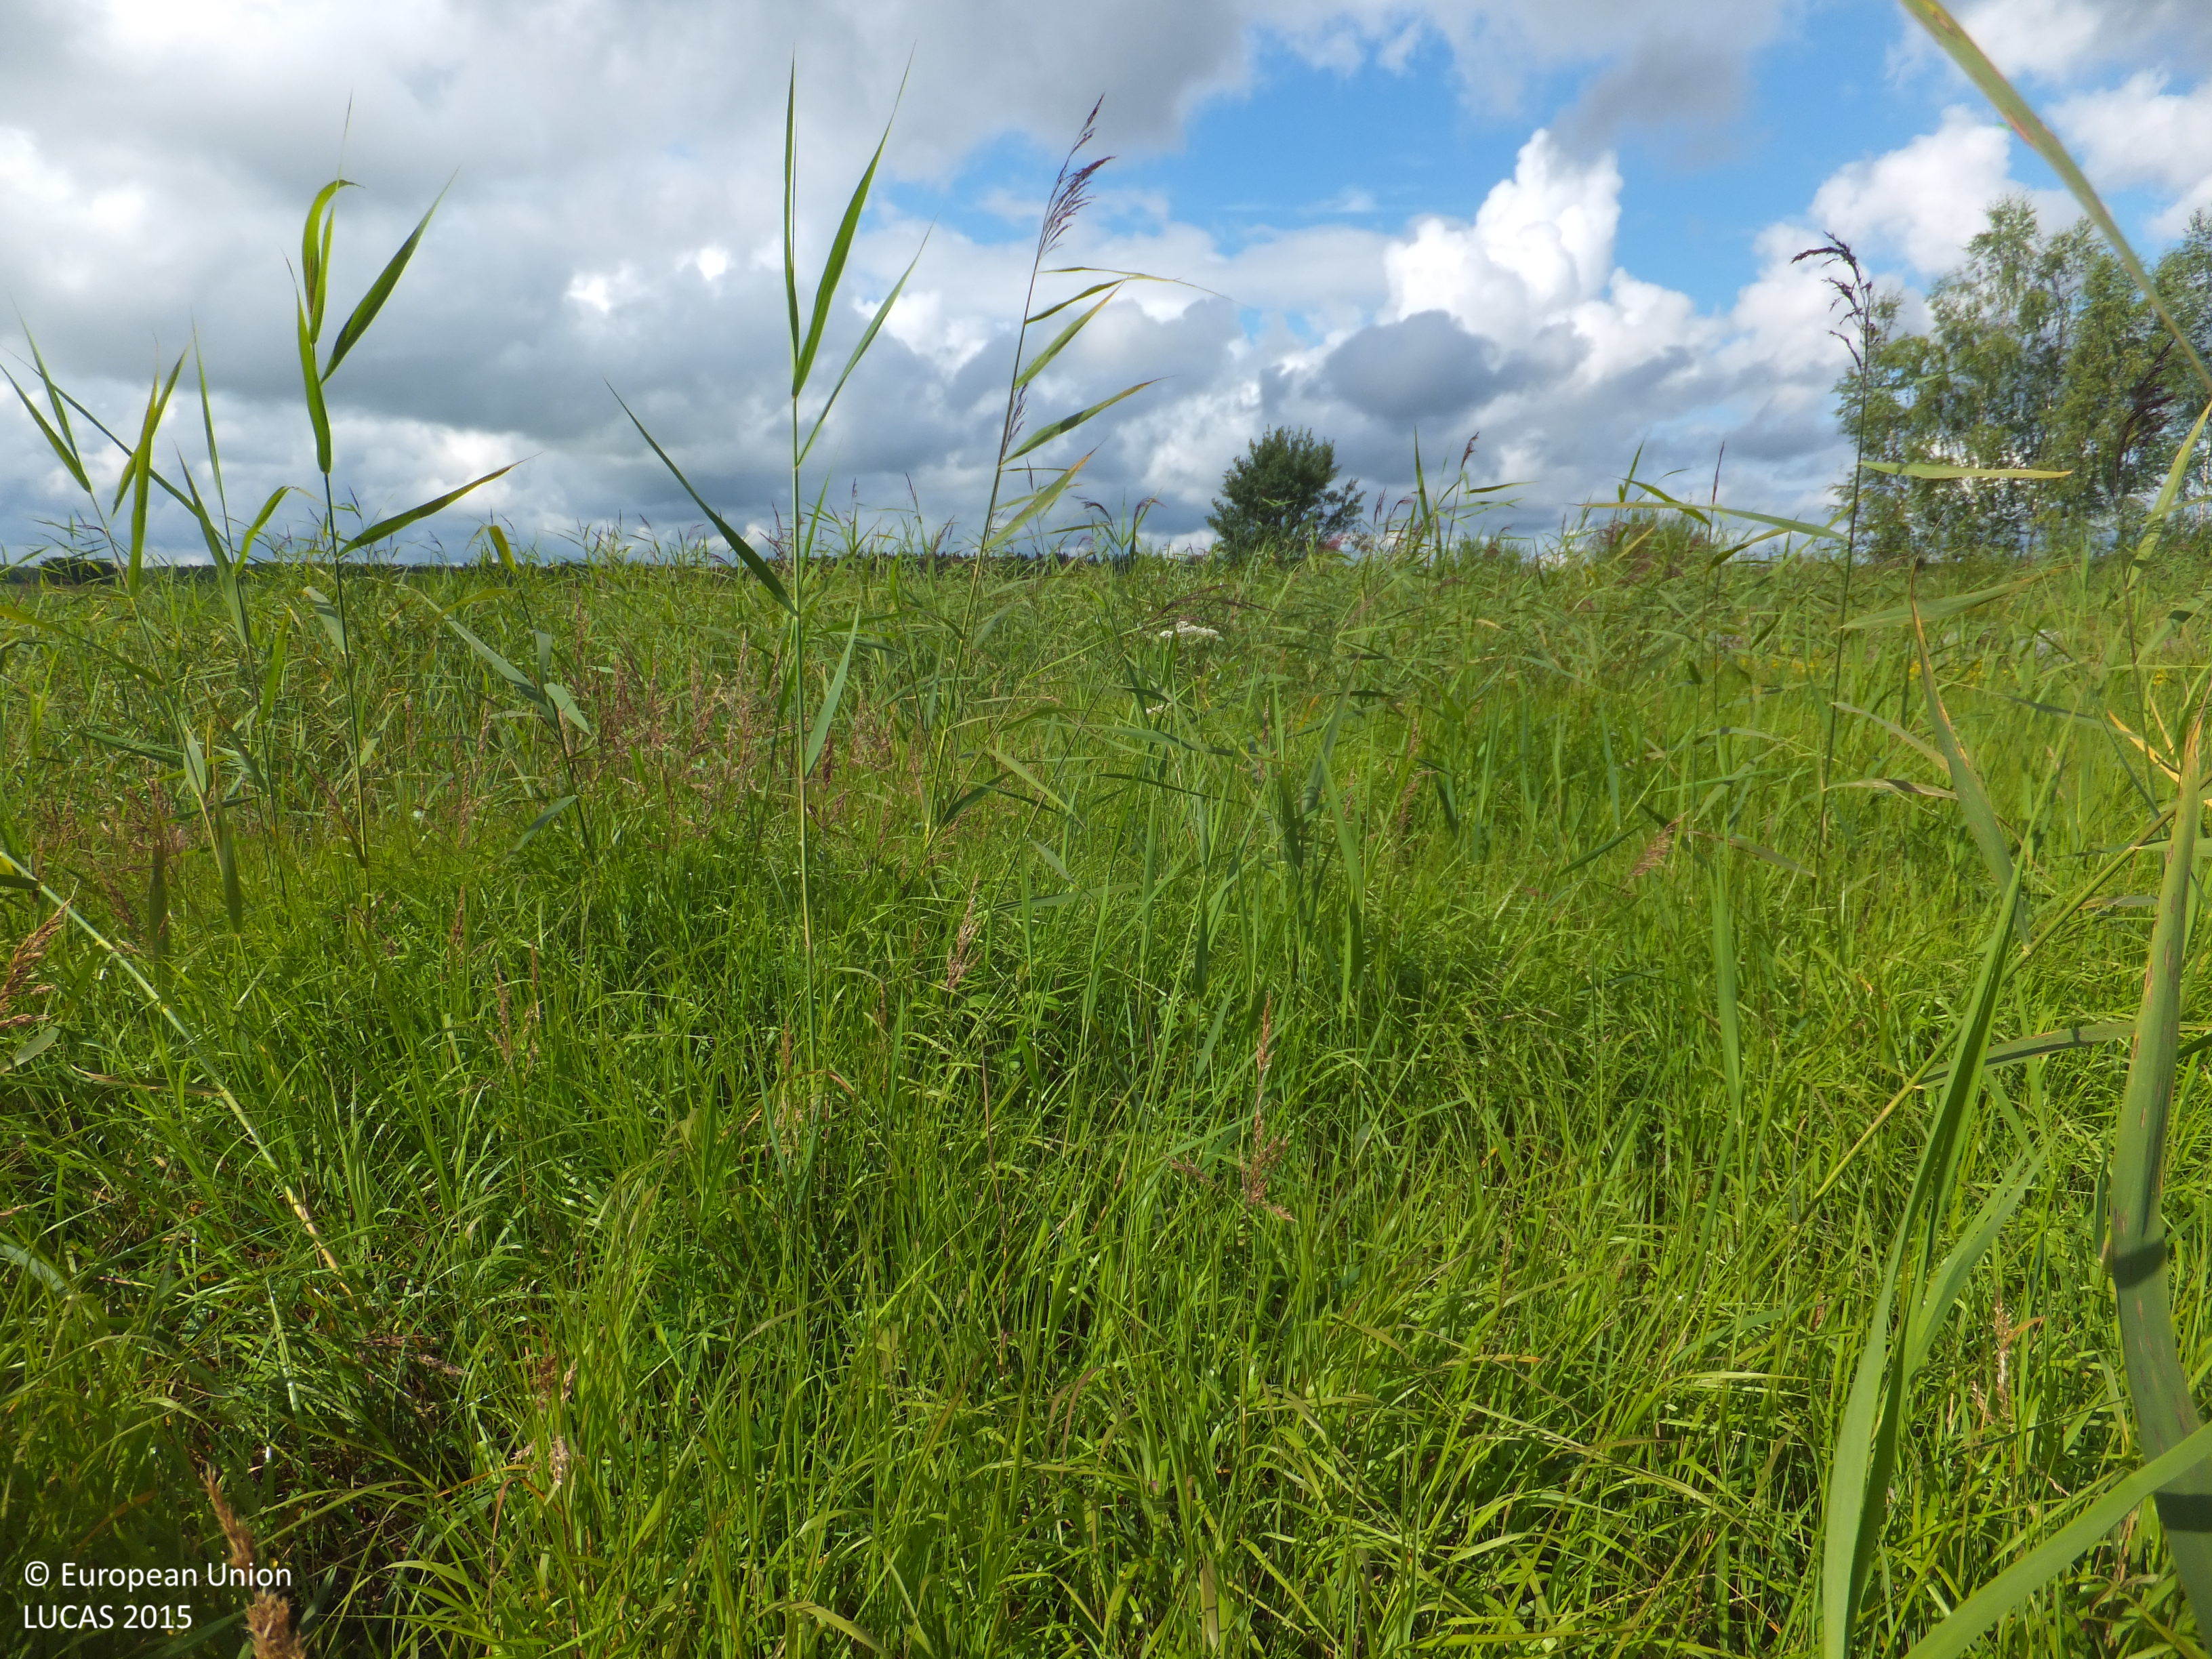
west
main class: Grassland
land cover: Grassland without tree/shrub cover
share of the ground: > 75 %
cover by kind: herbaceous plants 100 %
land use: Semi-natural and natural areas not in use
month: July
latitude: 63.2243
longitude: 22.0414
